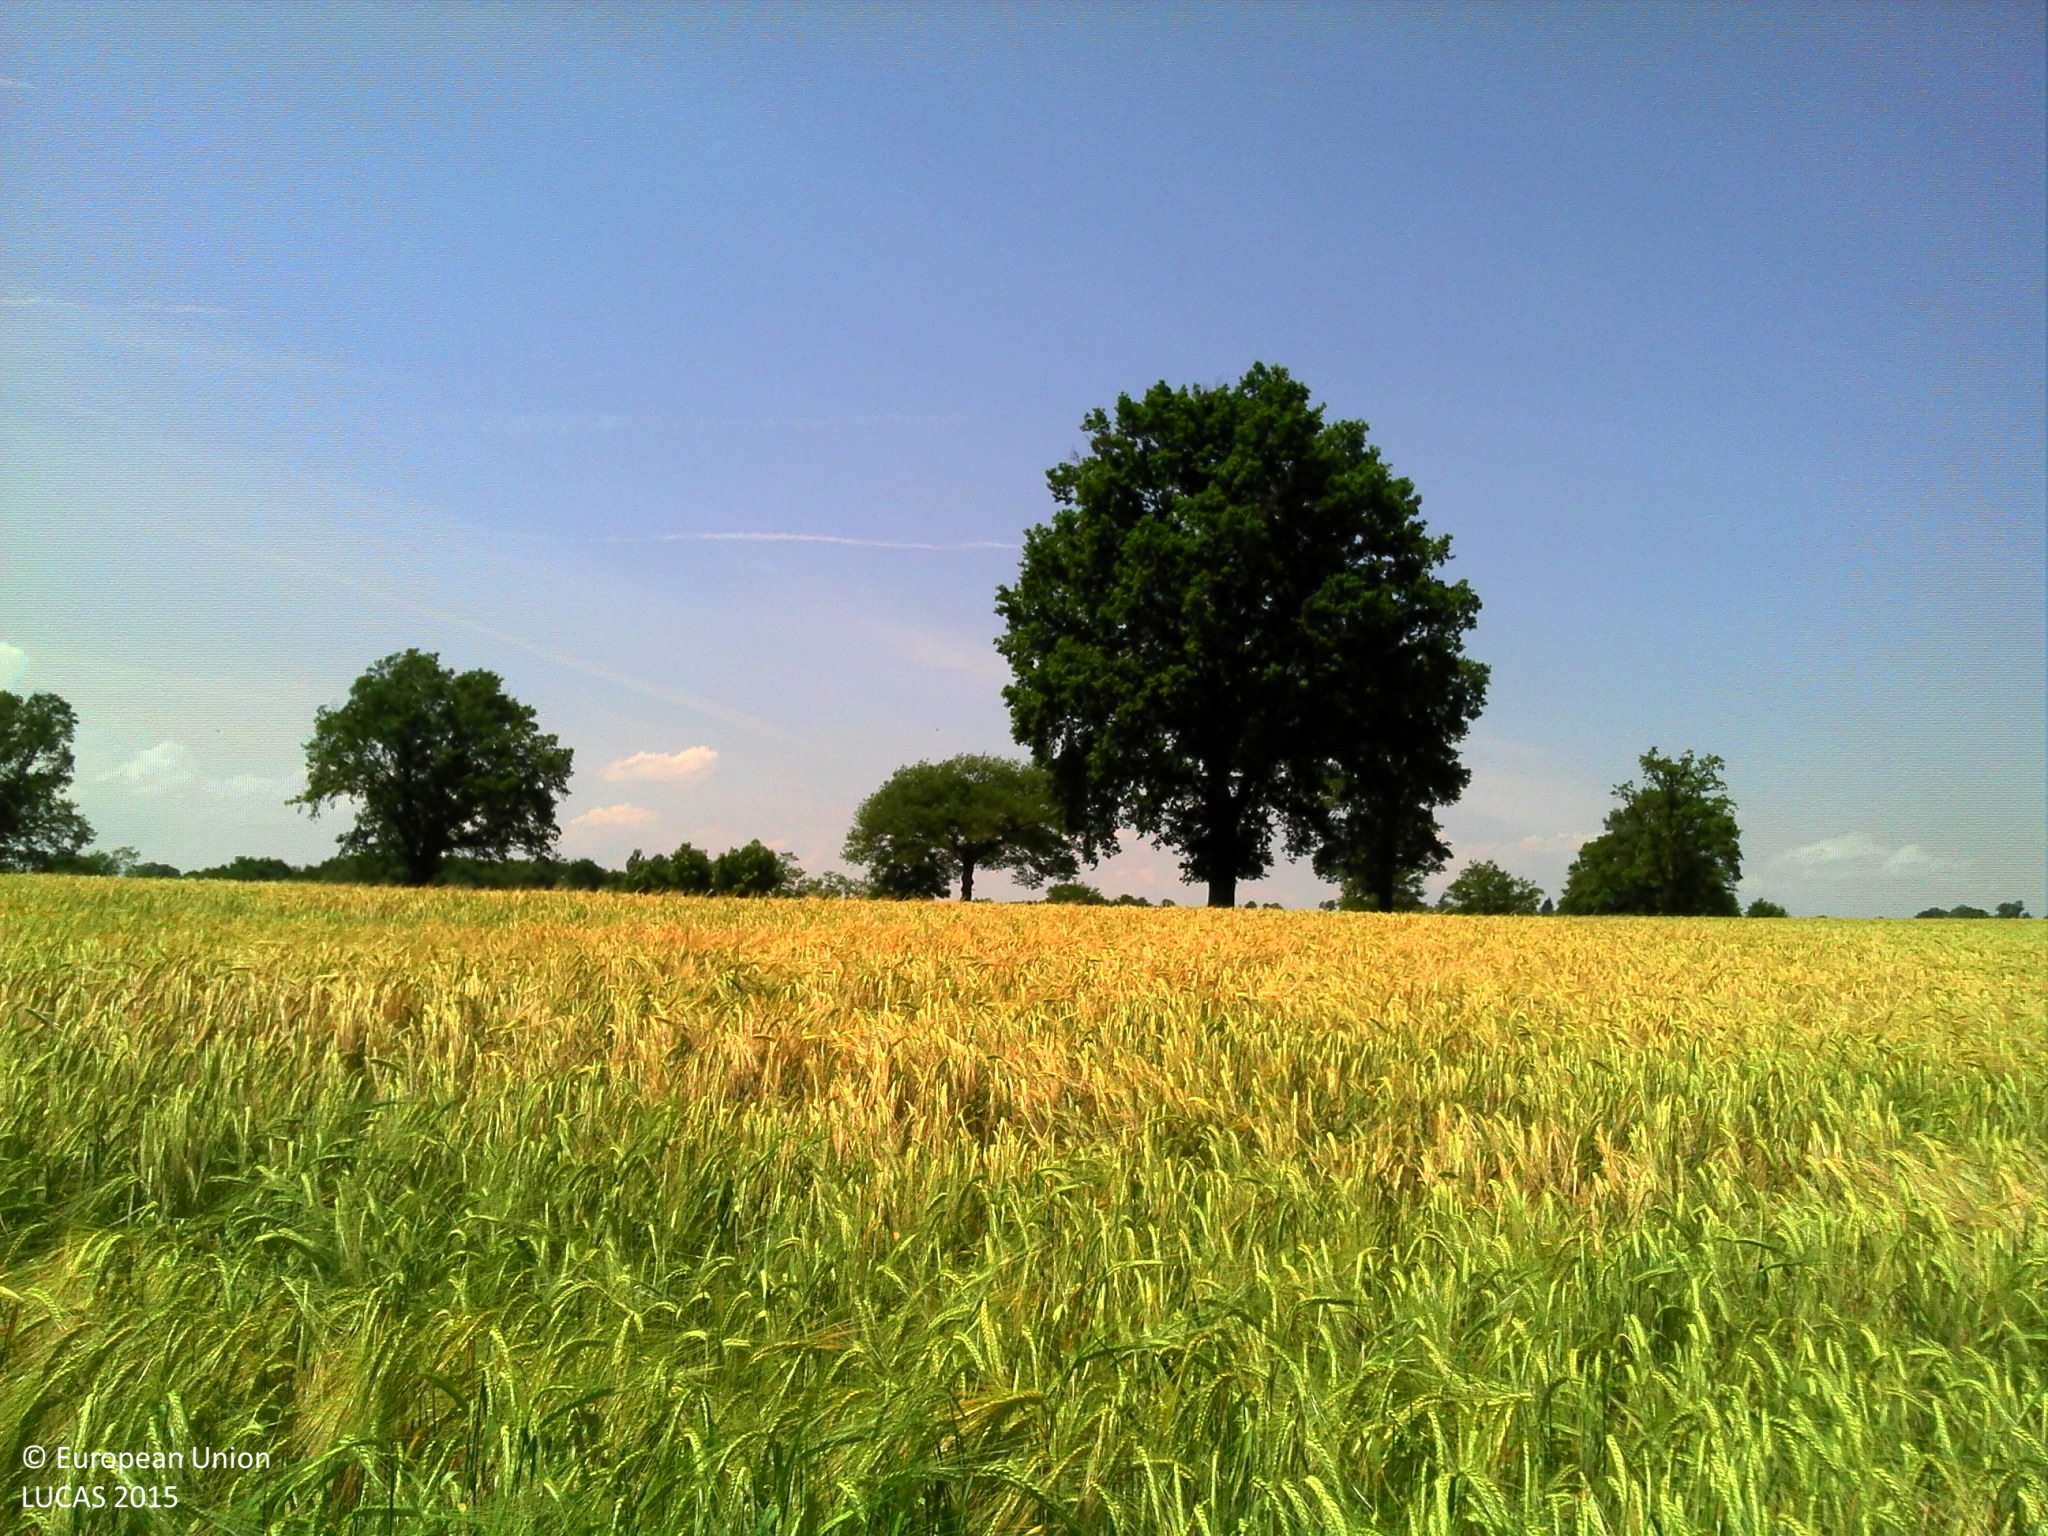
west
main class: Cropland
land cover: Barley
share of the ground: > 75 %
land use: Agriculture (excluding fallow land and kitchen gardens)
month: June
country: FR
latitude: 46.3597
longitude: 3.0444
